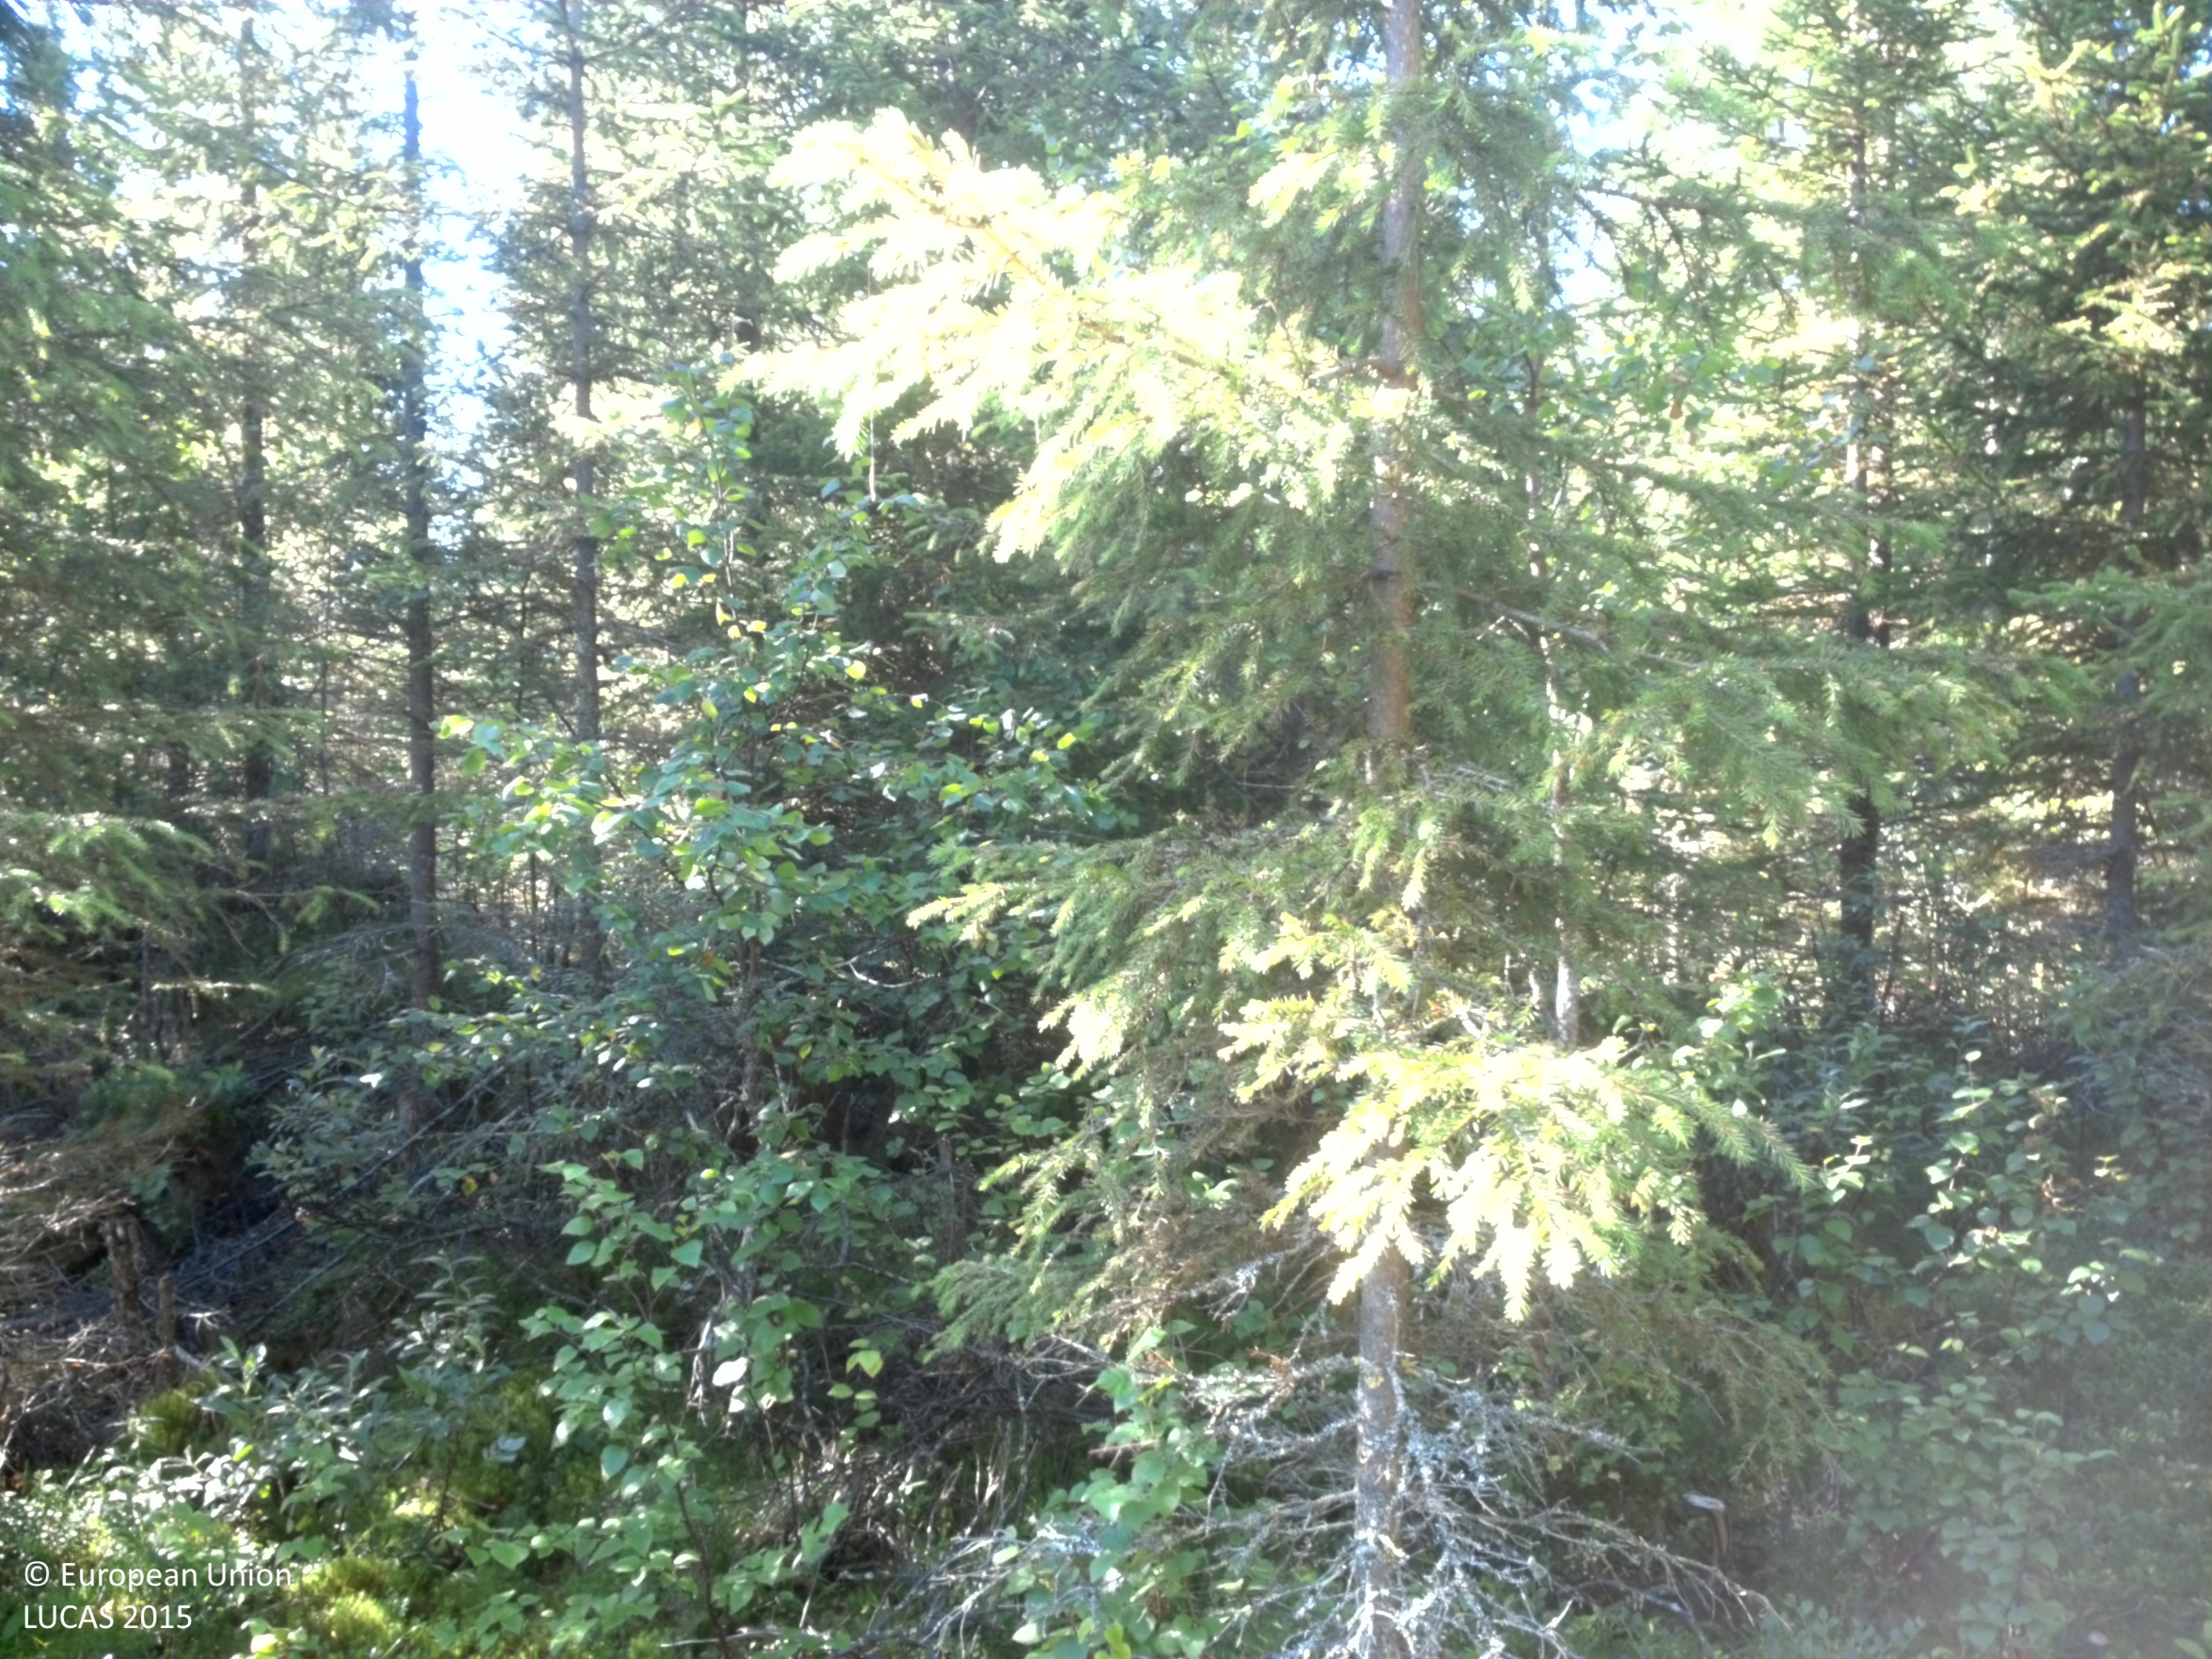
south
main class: Woodland
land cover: Spruce dominated mixed woodland
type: boreal forest
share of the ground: > 75 %
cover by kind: coniferous forest trees 60 %, broadleaved forest trees 20 %, shrubs 15 %, lichens and mosses 5 %
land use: Forestry
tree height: > 5 m
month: August
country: SE
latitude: 64.4468
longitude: 18.4253
